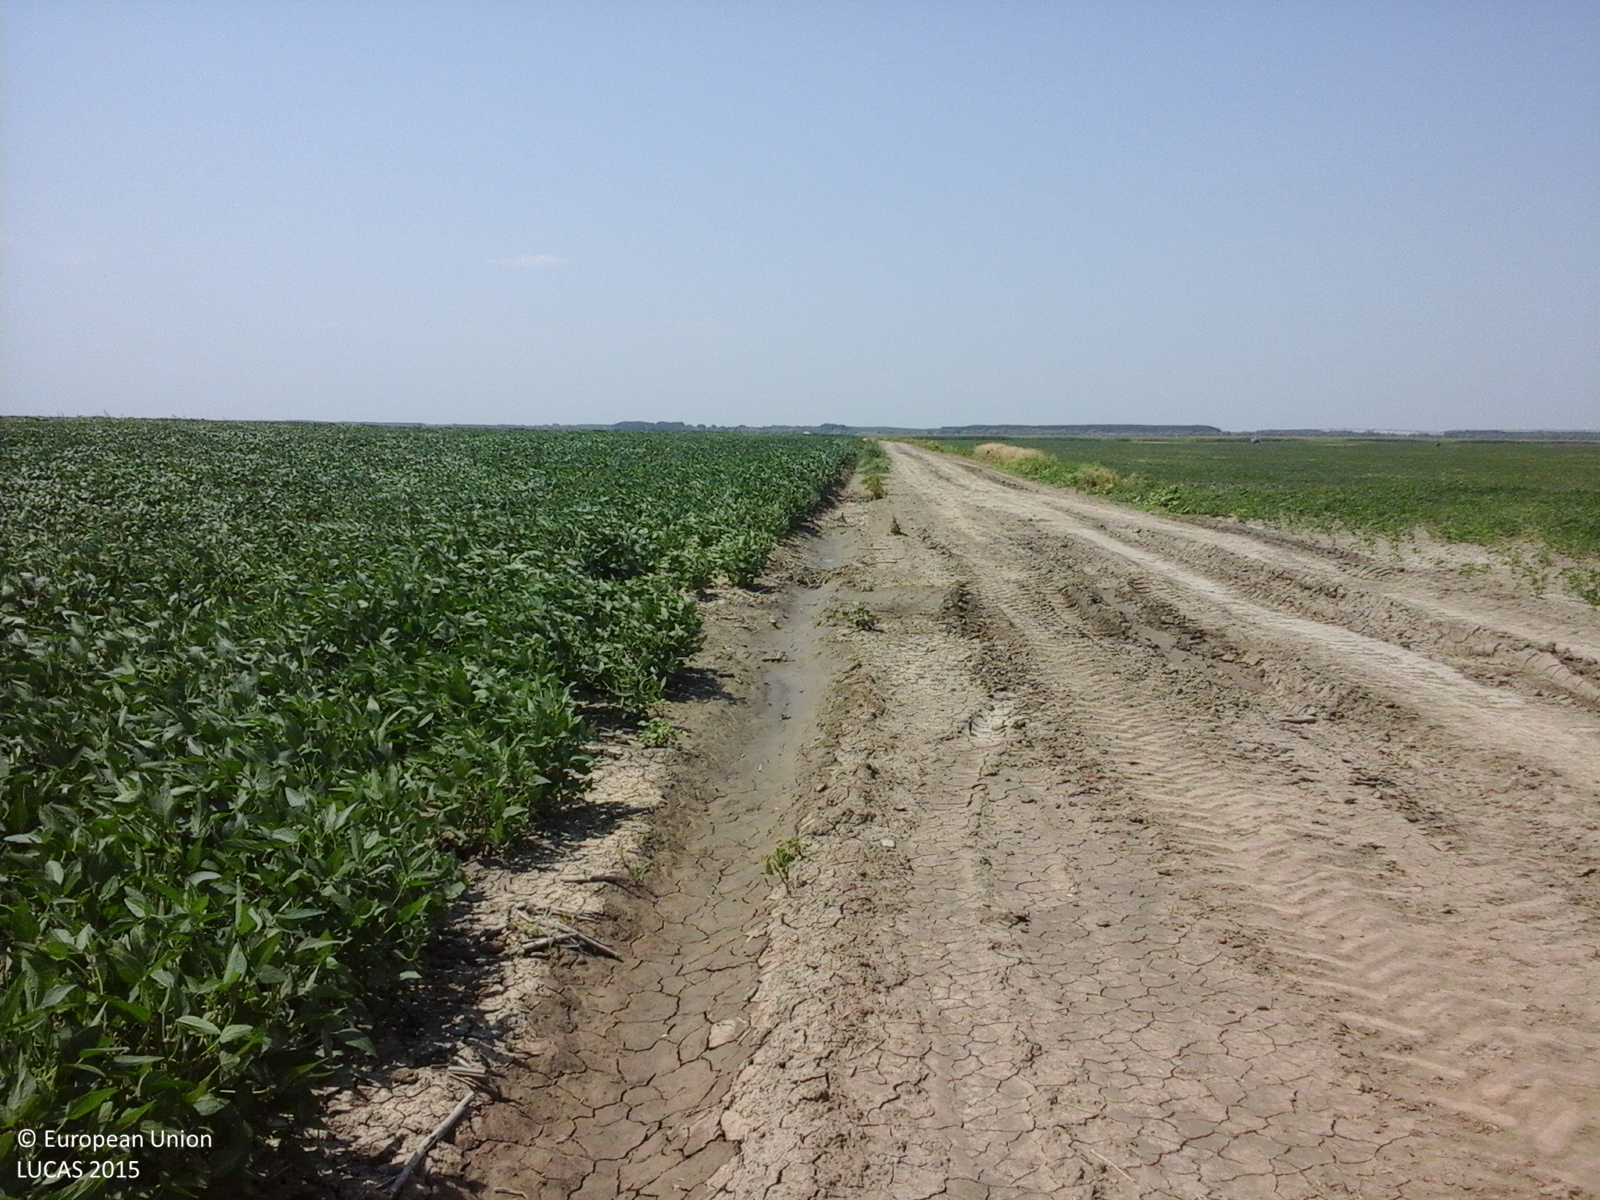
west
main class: Cropland
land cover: Soya
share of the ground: > 75 %
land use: Agriculture (excluding fallow land and kitchen gardens)
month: August
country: RO
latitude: 45.1036
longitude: 27.9950
